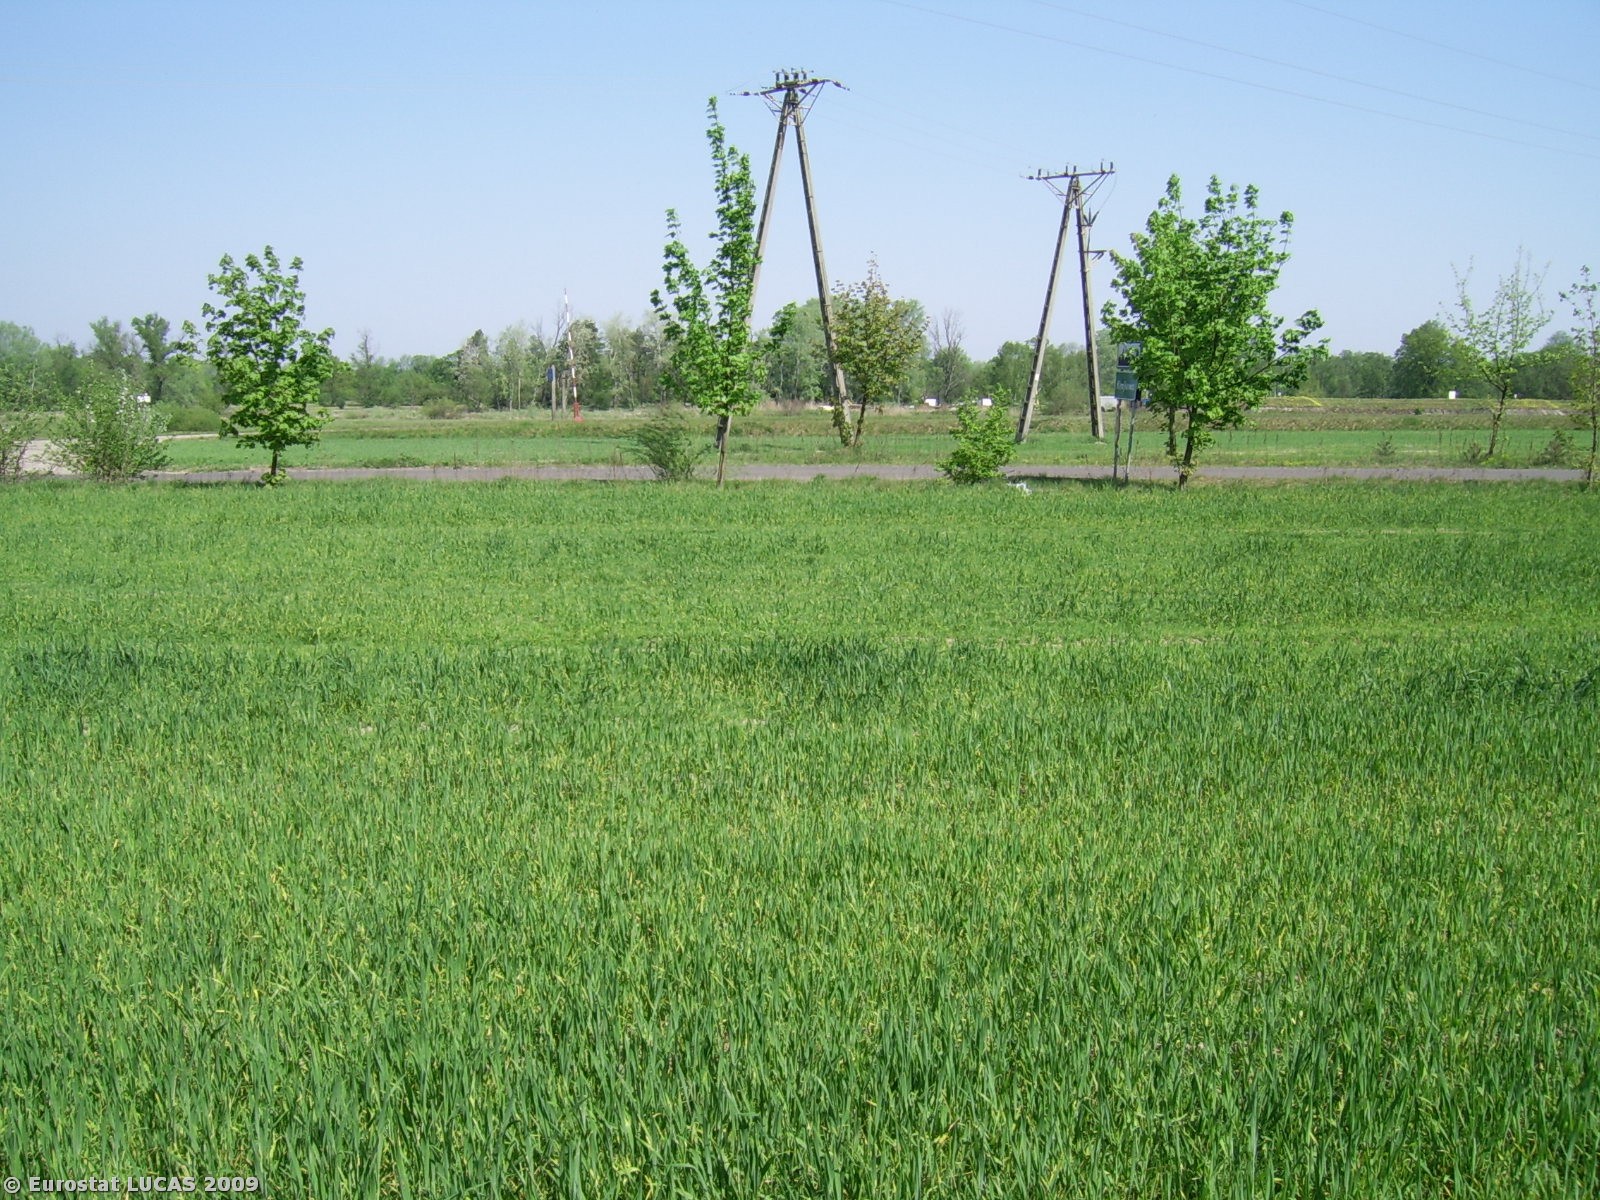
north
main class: Cropland
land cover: Common wheat
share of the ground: > 75 %
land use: Agriculture (excluding fallow land and kitchen gardens)
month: April
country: PL
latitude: 52.2109
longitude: 16.9318
